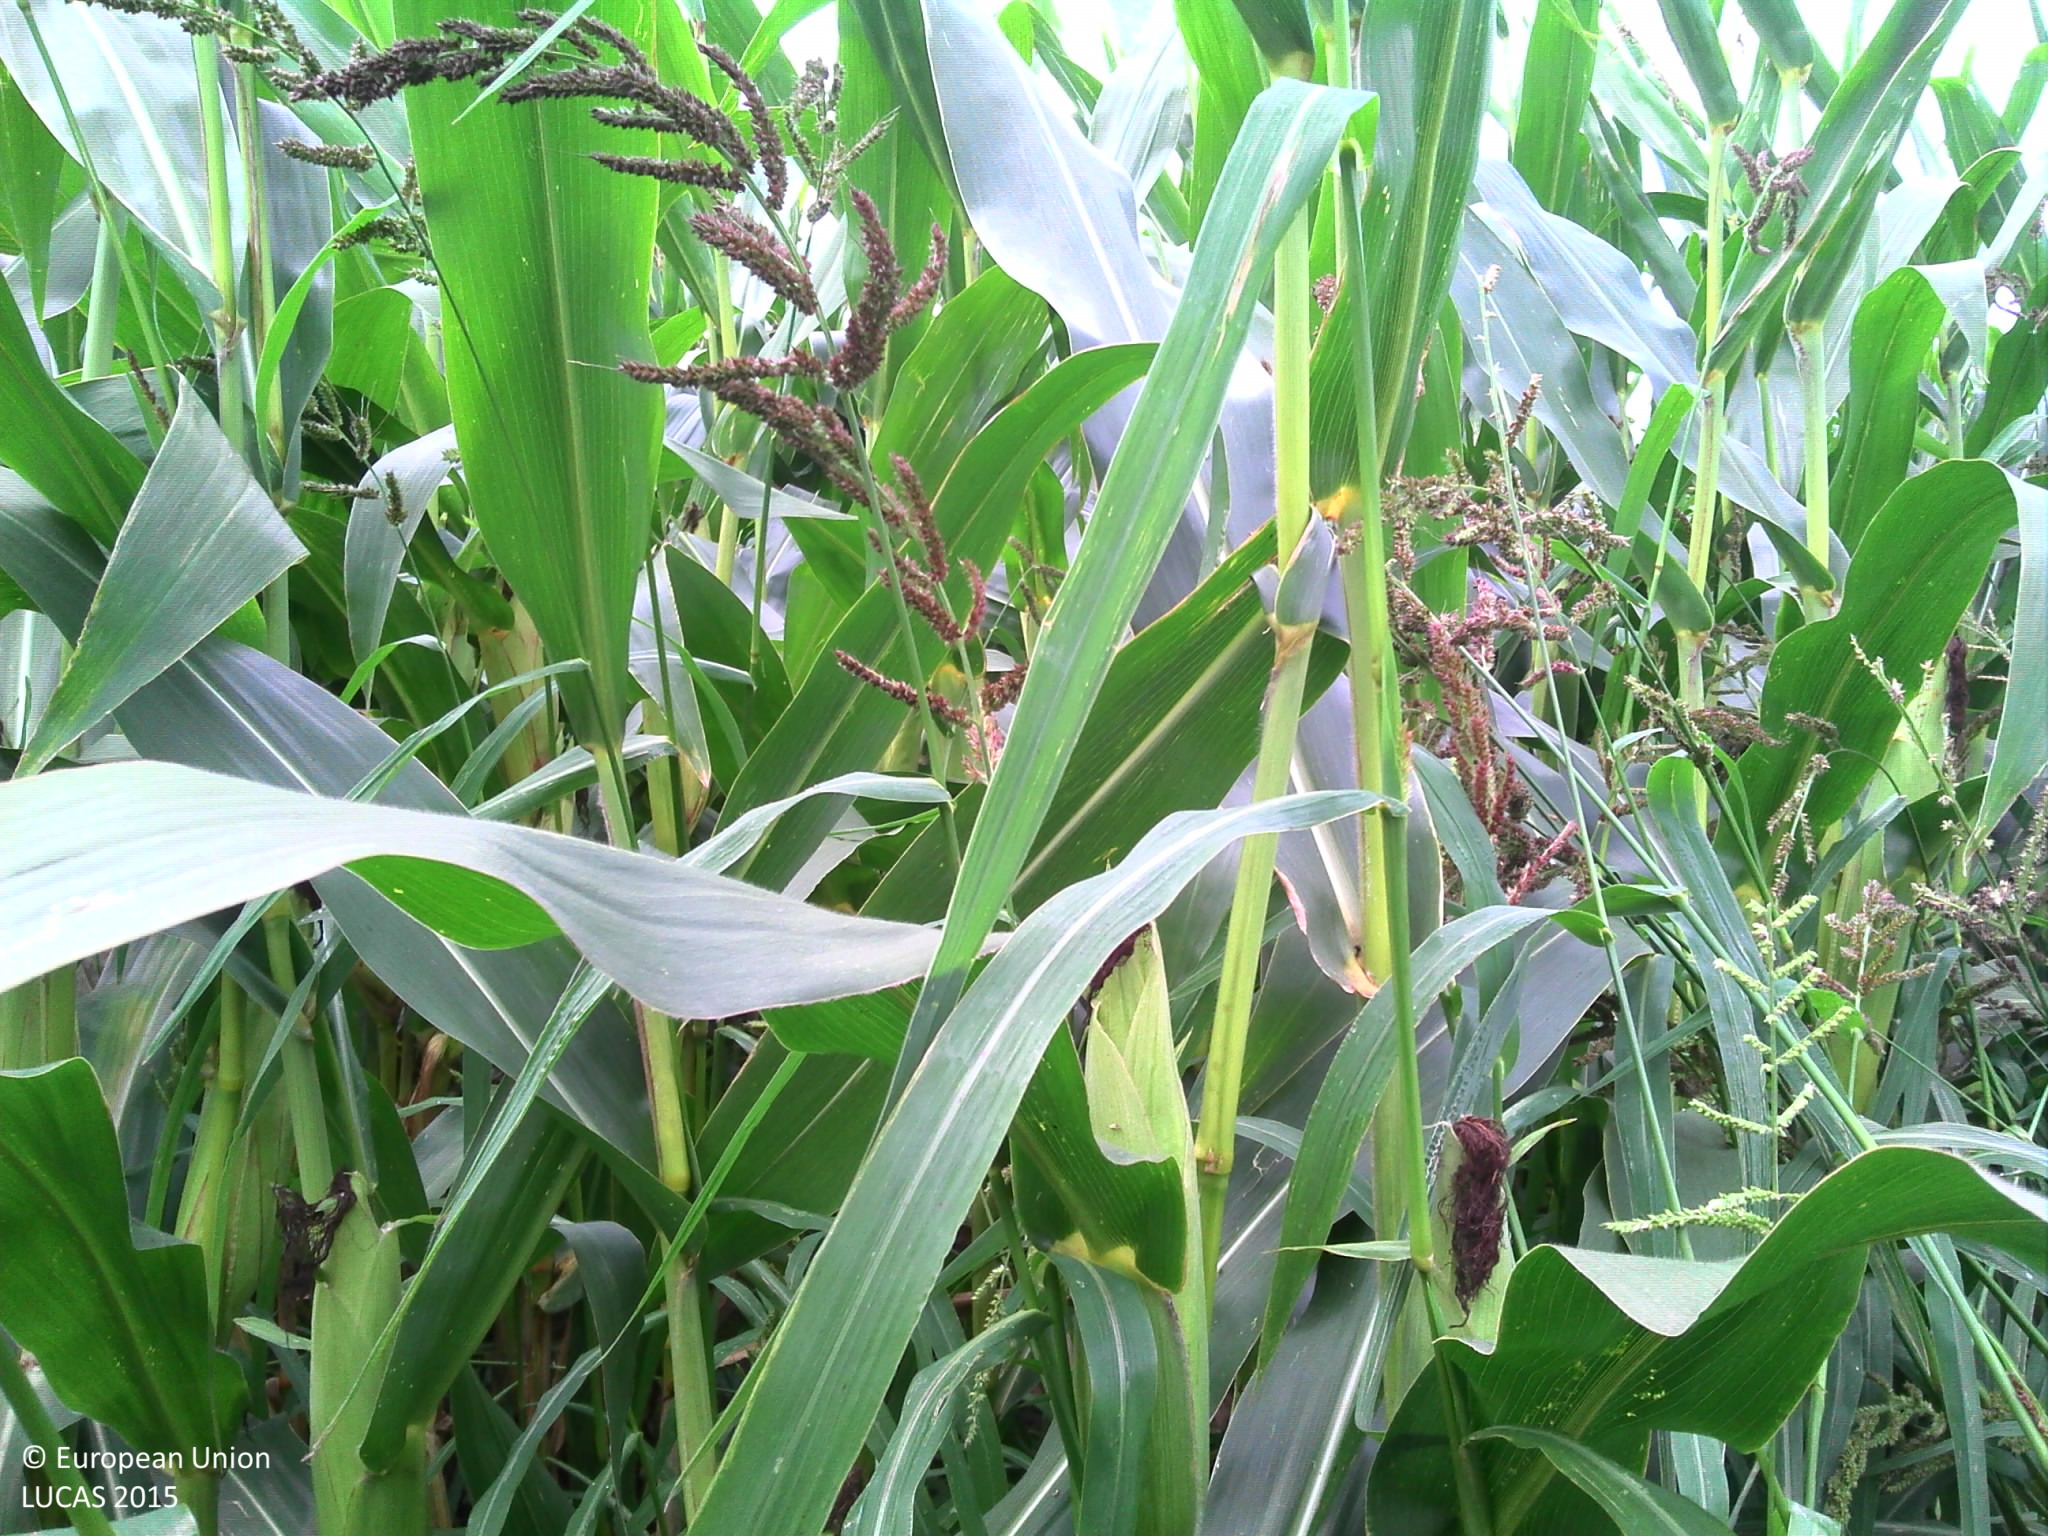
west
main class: Cropland
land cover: Maize
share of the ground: > 75 %
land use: Agriculture (excluding fallow land and kitchen gardens)
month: September
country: BE
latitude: 50.9084
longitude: 2.7212
